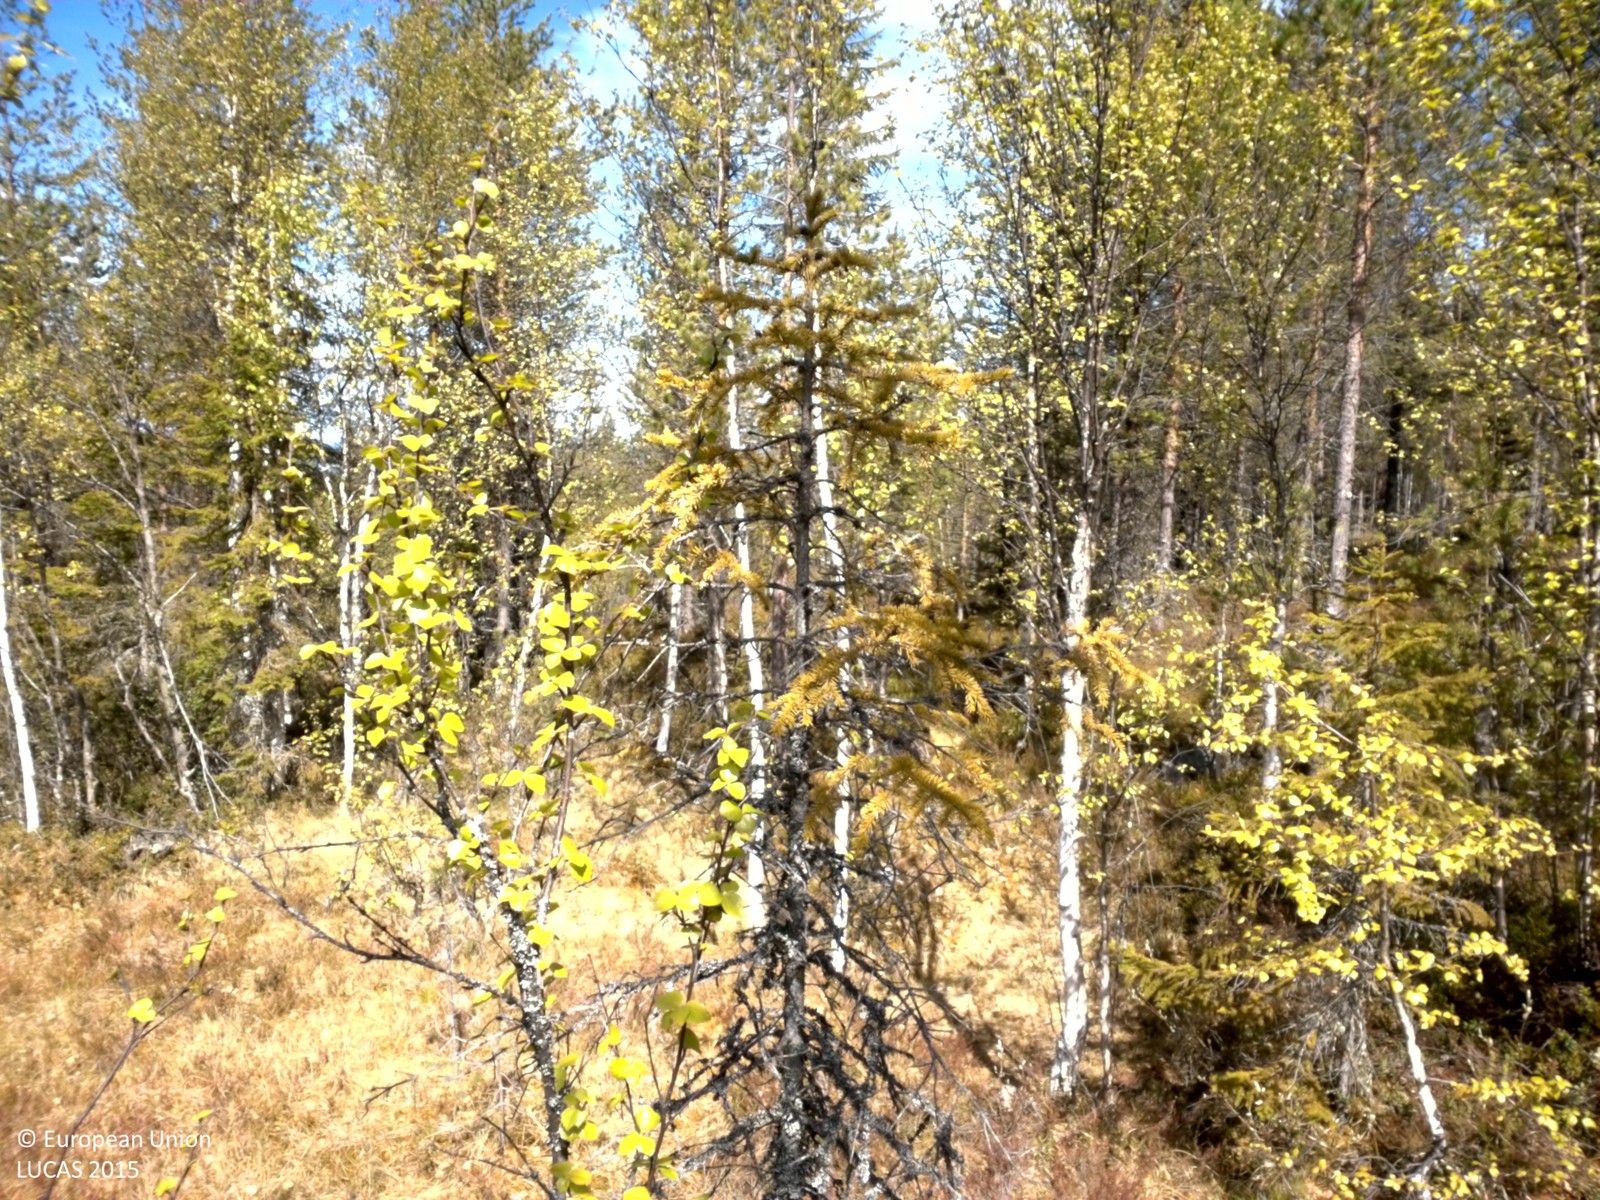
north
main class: Woodland
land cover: Pine dominated mixed woodland
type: boreal forest
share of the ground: 25 - 50 %
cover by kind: coniferous forest trees 30 %, herbaceous plants 20 %, broadleaved forest trees 15 %, lichens and mosses 15 %, shrubs 10 %, unconsolidated bare surface 10 %
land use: Forestry
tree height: > 5 m
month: June
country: SE
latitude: 64.3401
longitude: 17.2746
